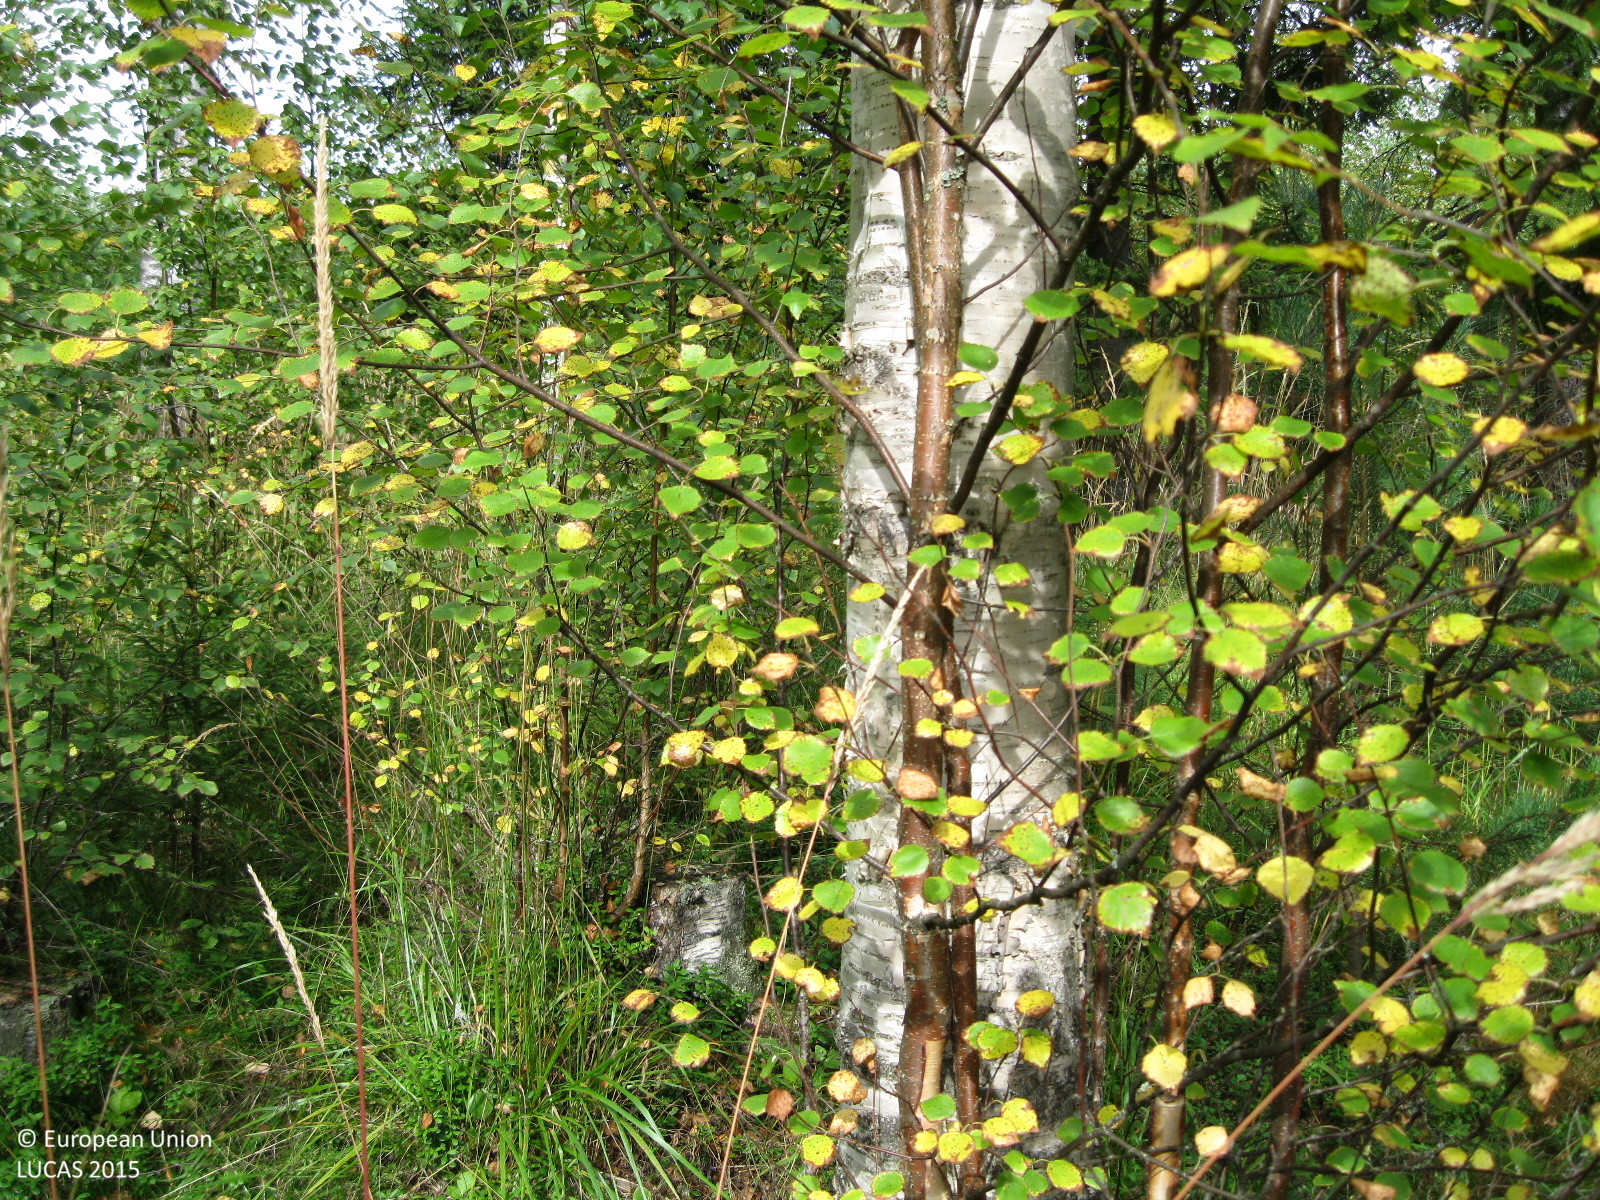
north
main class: Woodland
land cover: Spruce dominated mixed woodland
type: boreal forest
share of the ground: > 75 %
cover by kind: coniferous forest trees 45 %, broadleaved forest trees 35 %, shrubs 10 %, herbaceous plants 10 %
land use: Forestry
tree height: > 5 m
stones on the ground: < 10 %
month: September
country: FI
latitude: 60.7196
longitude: 24.9431
